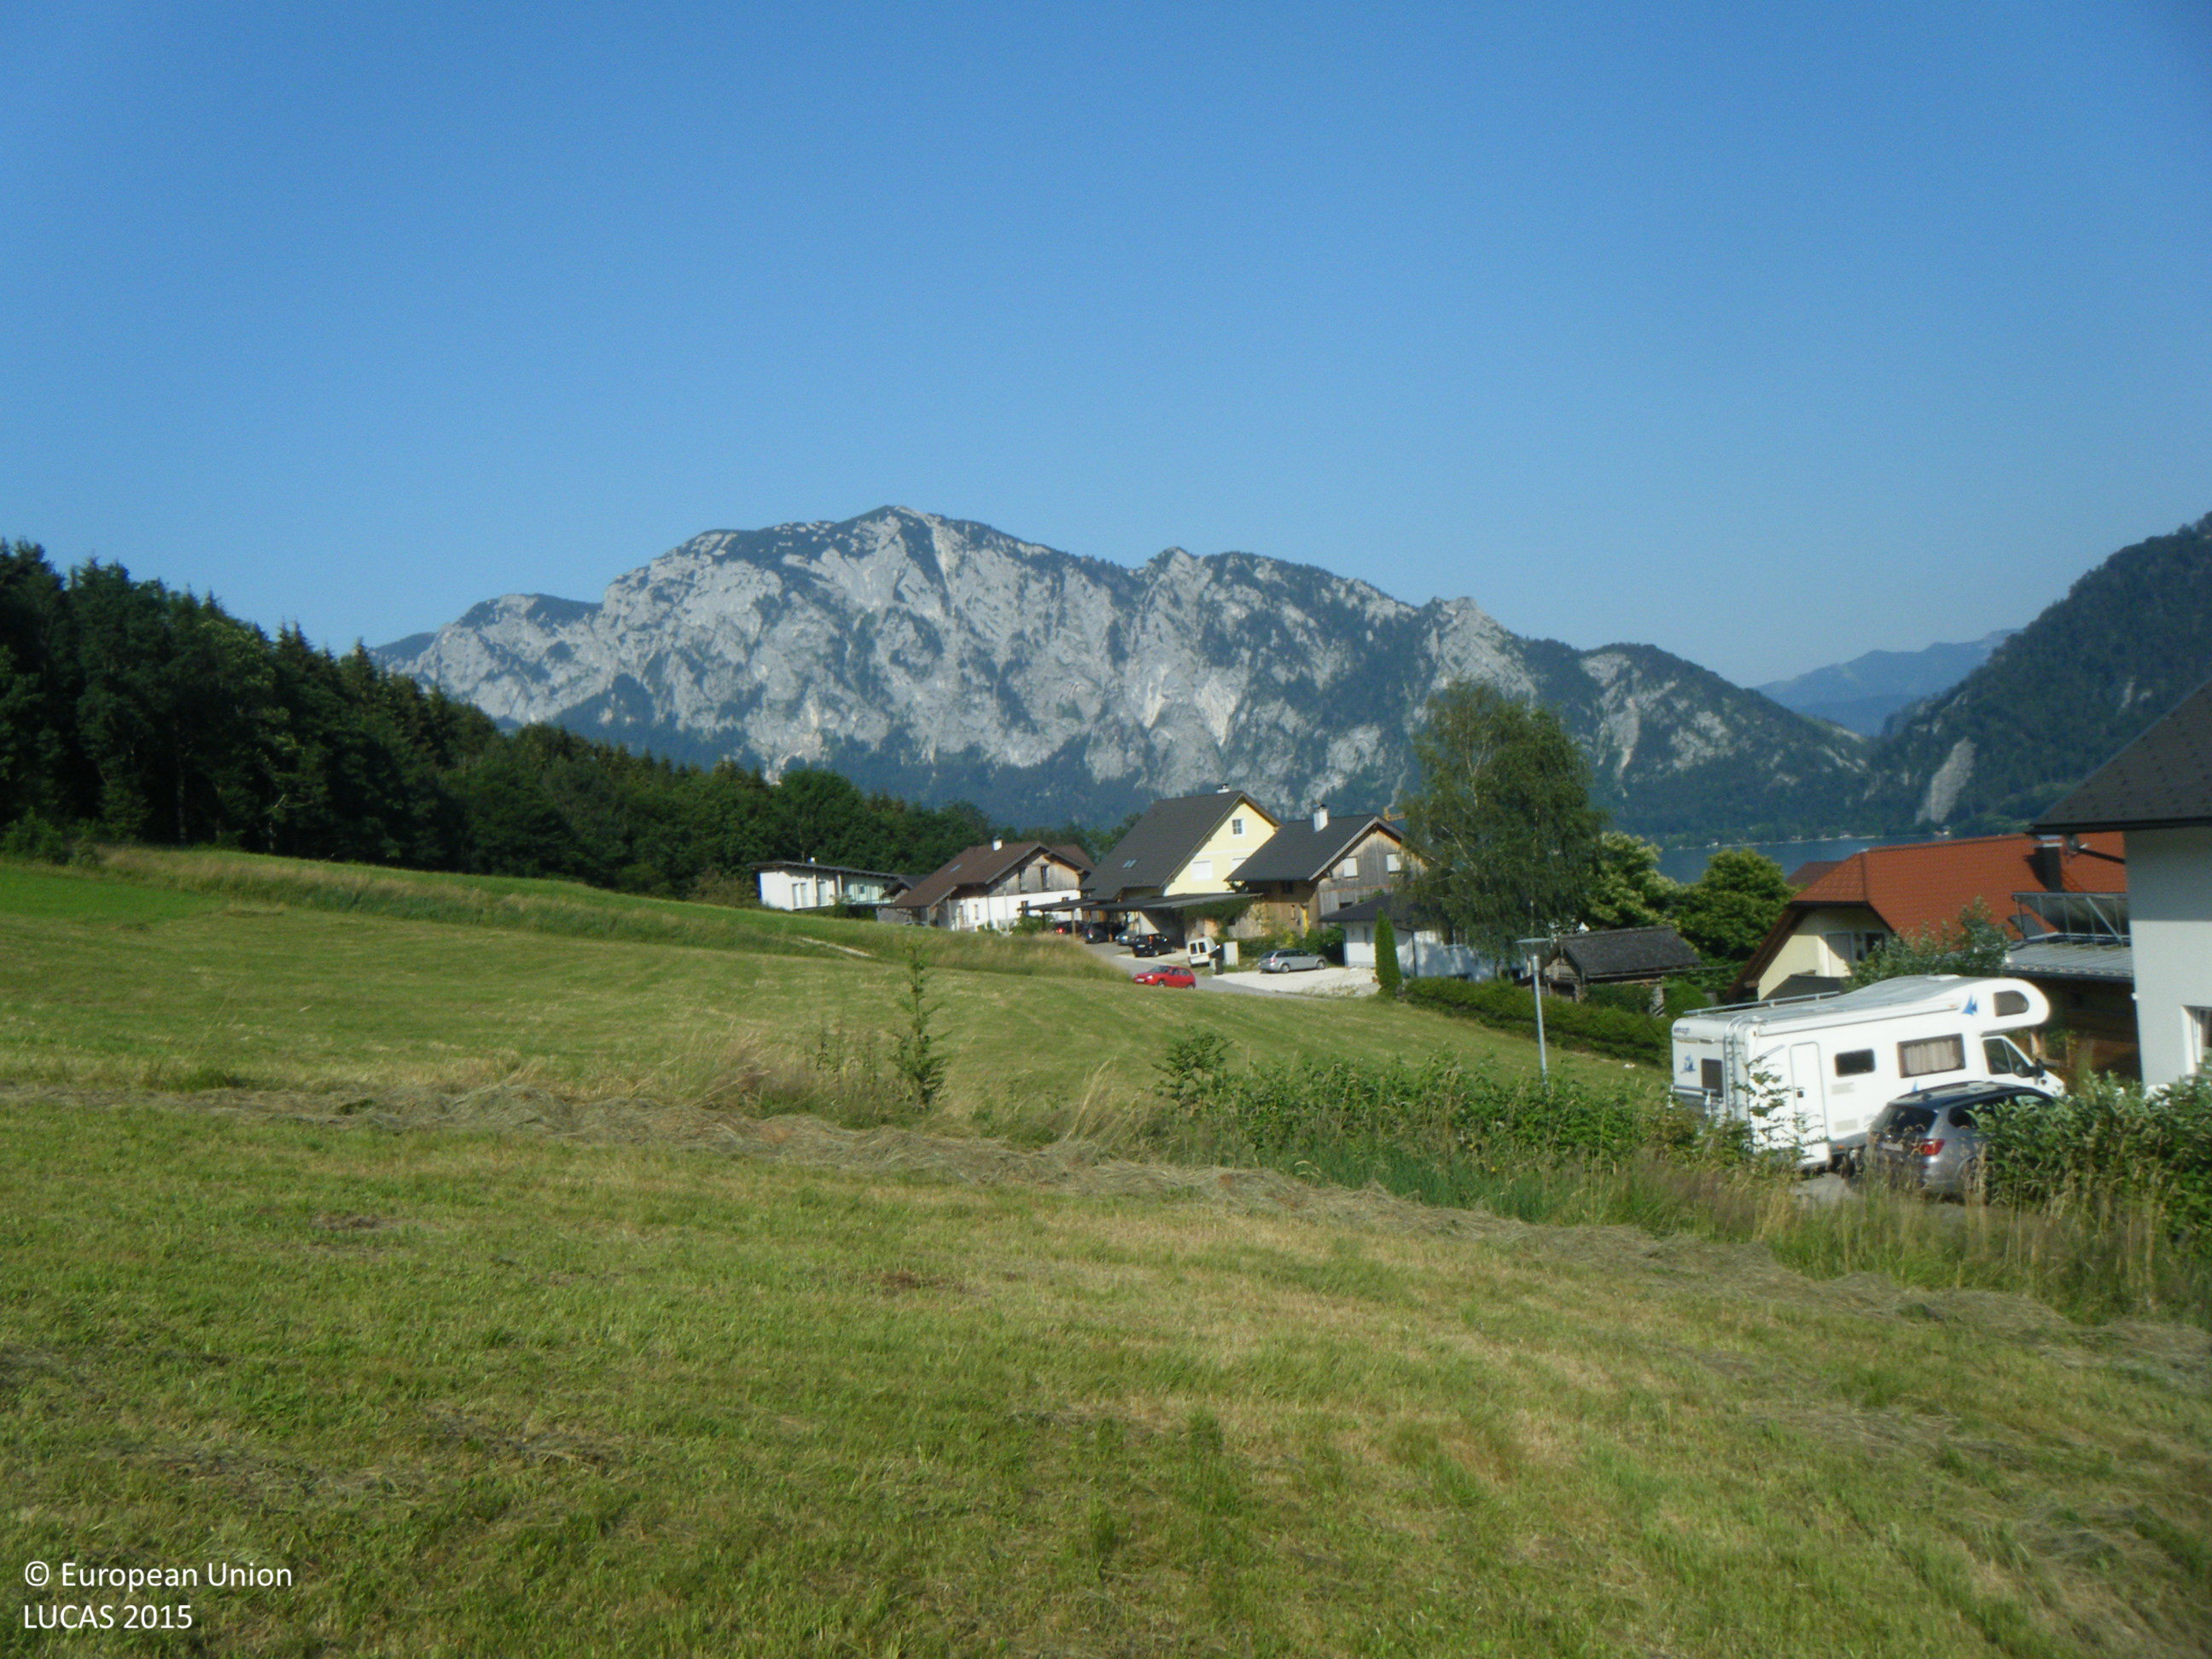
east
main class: Grassland
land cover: Grassland without tree/shrub cover
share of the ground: > 75 %
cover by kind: herbaceous plants 100 %
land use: Agriculture (excluding fallow land and kitchen gardens)
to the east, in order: Grassland without tree/shrub cover; Shrubland without tree cover; Spontaneously vegetated surfaces; Grassland without tree/shrub cover; Tracks; Grassland without tree/shrub cover; Artificial constructions in urban areas
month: July
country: AT
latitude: 47.8083
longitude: 13.4840
